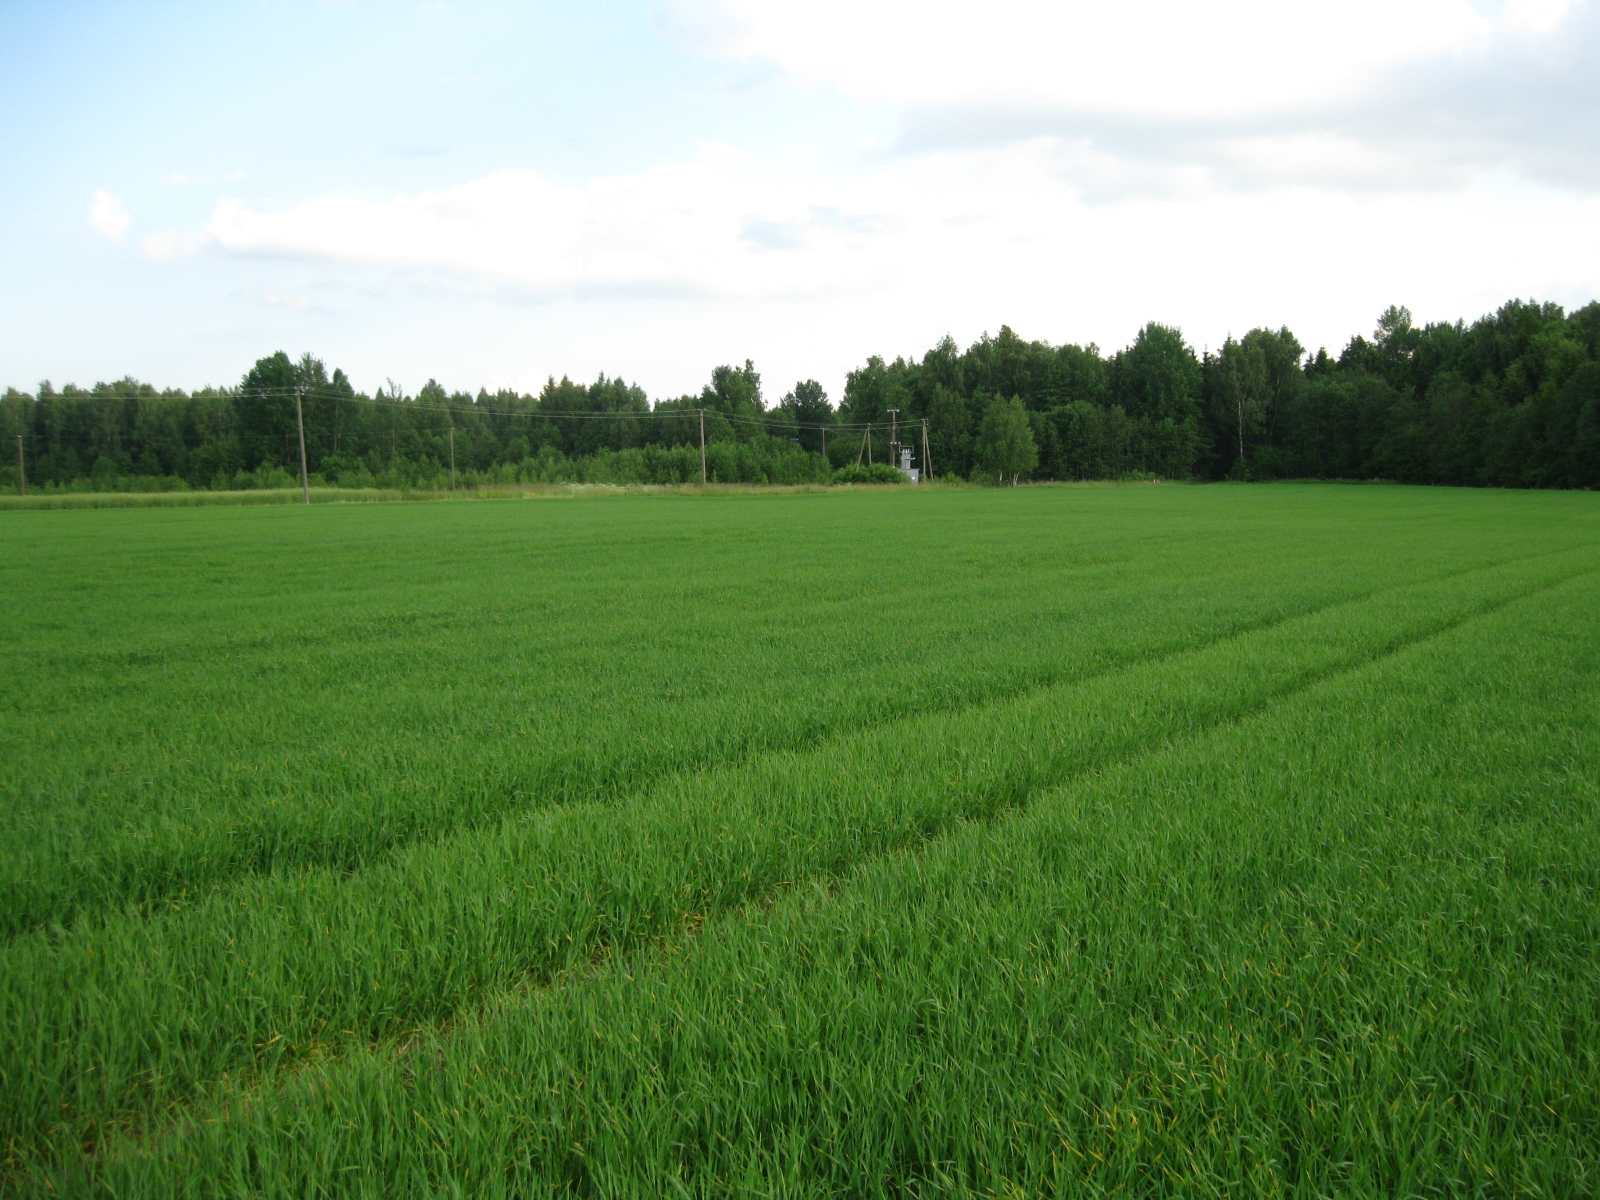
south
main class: Cropland
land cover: Barley
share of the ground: > 75 %
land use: Agriculture (excluding fallow land and kitchen gardens)
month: June
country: LT
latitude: 55.5753
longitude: 23.7075
